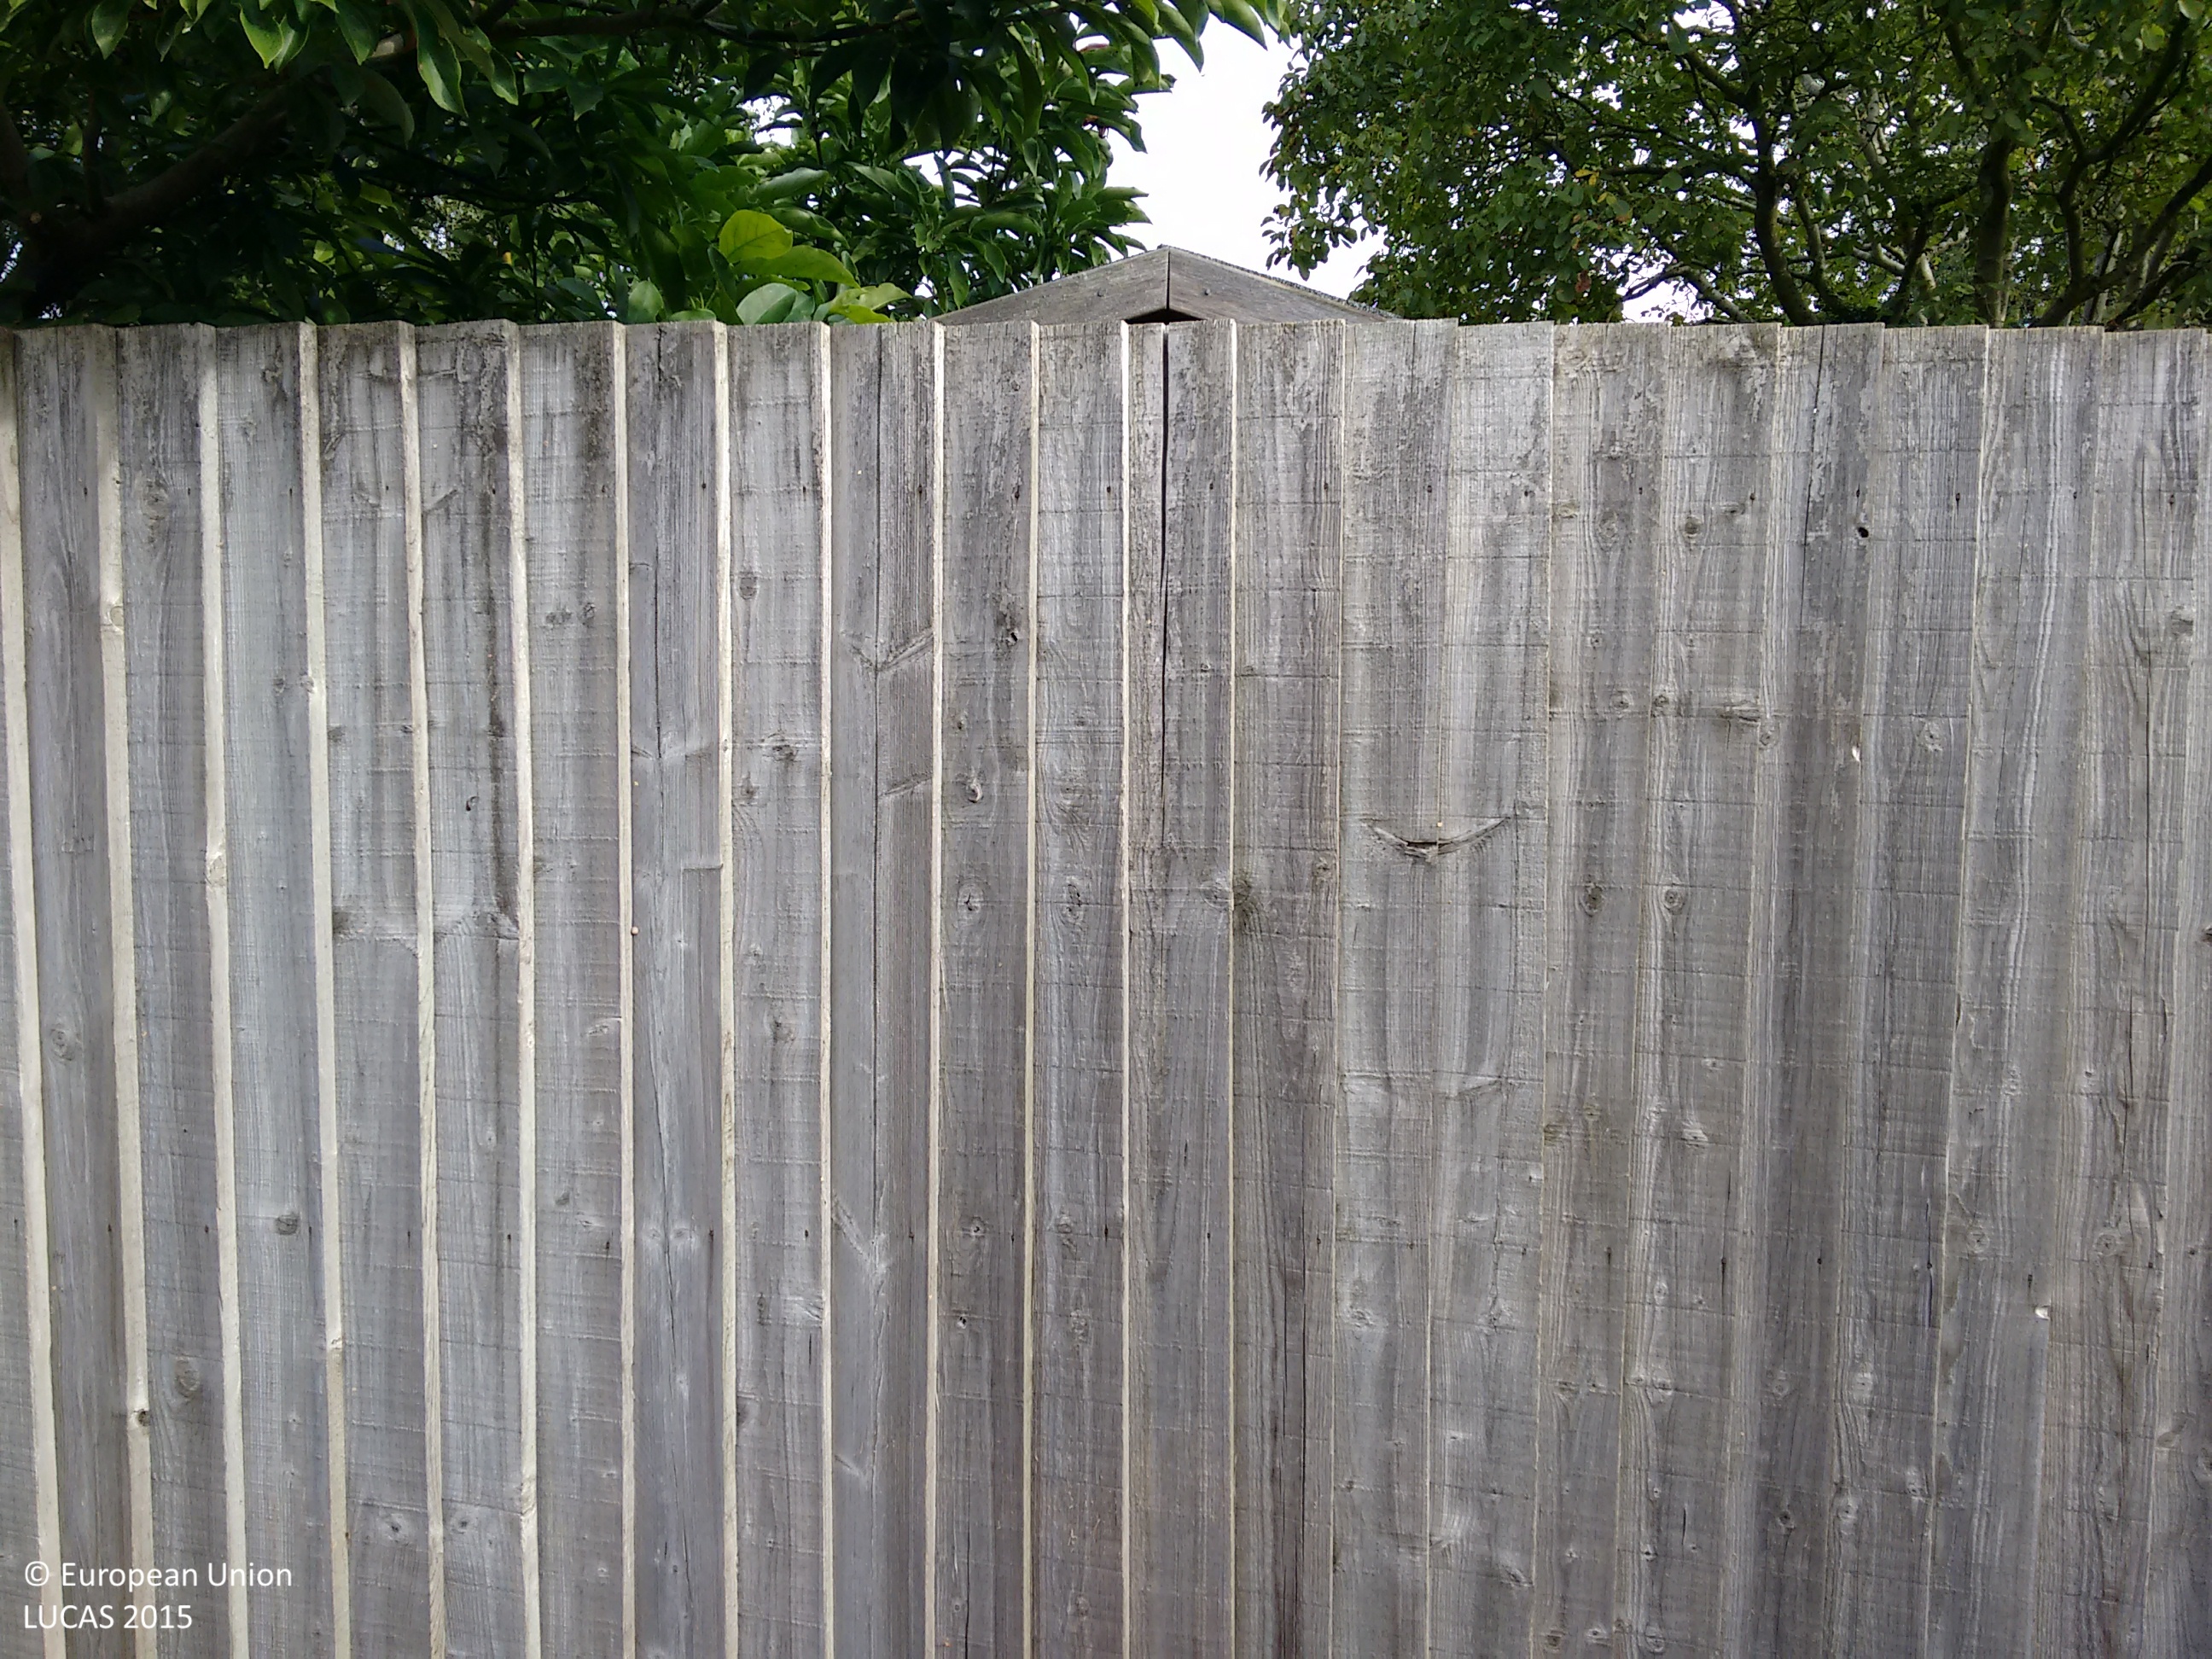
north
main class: Grassland
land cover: Grassland with sparse tree/shrub cover
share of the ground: > 75 %
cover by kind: herbaceous plants 95 %, broadleaved forest trees 5 %
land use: Residential
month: September
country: GB
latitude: 52.6324
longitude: 1.2469
